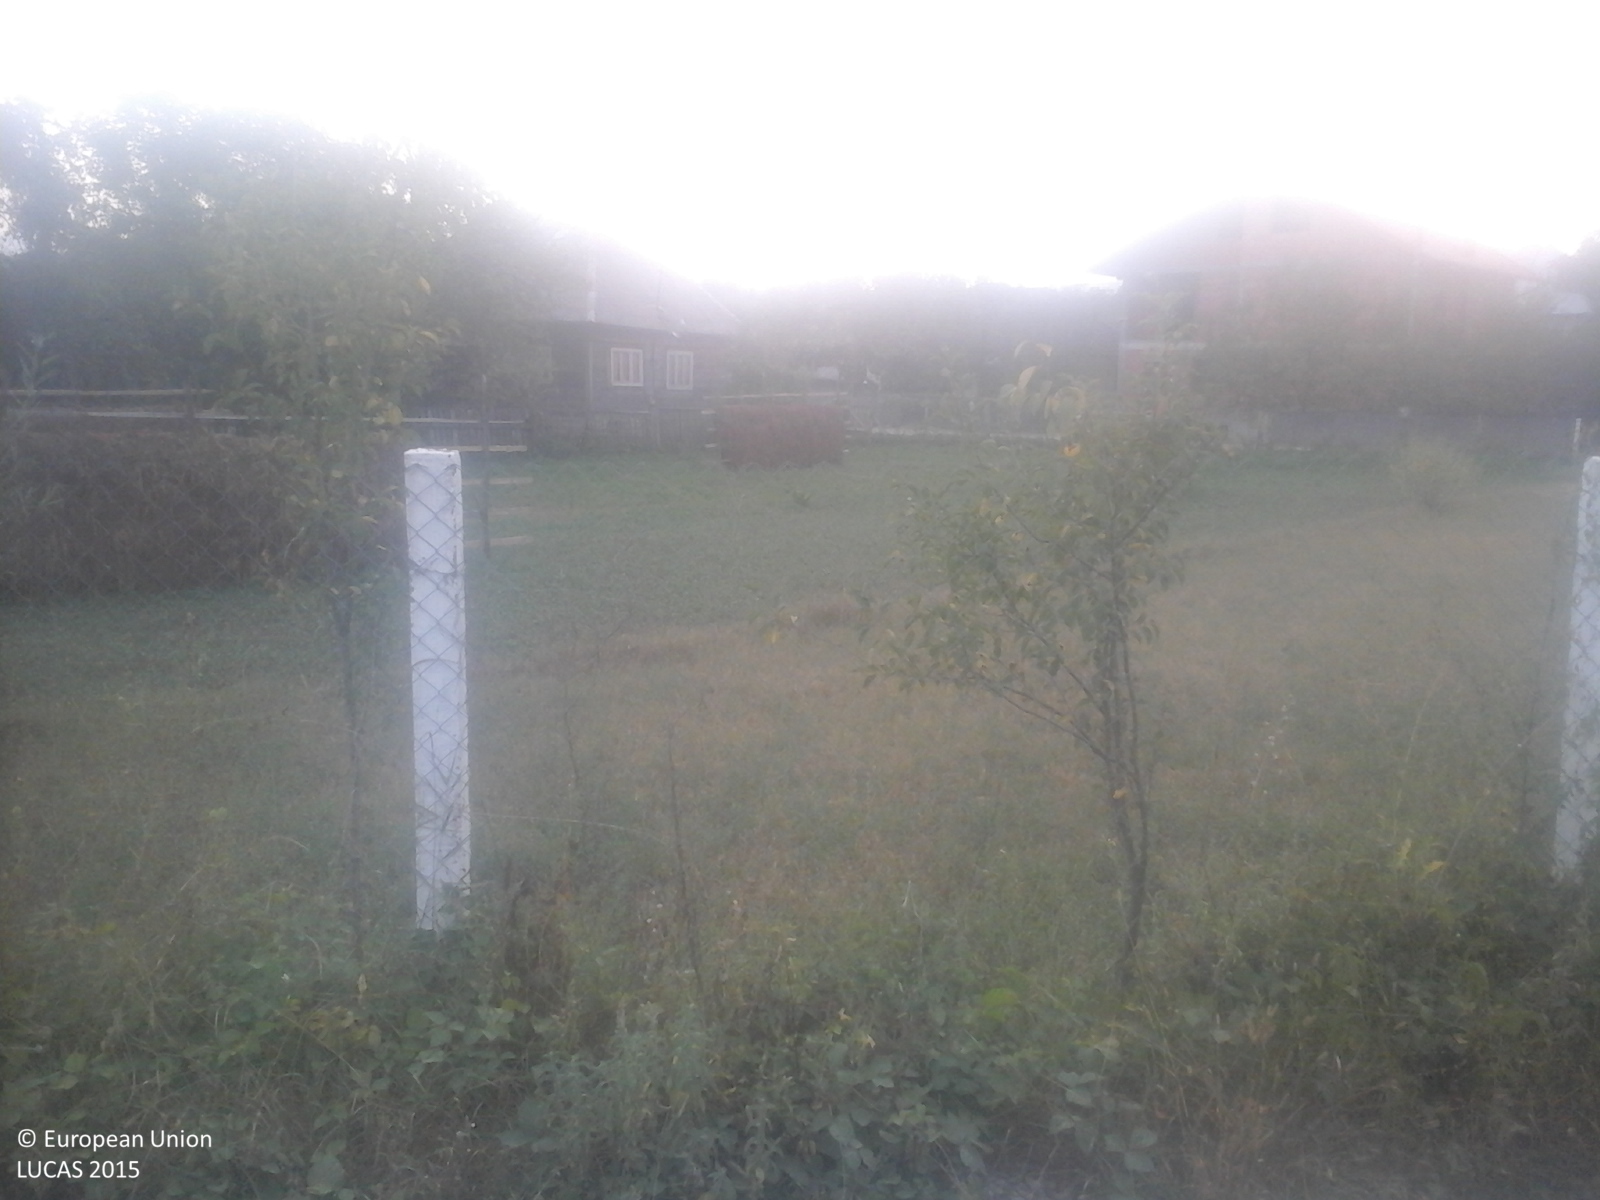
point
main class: Cropland
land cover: Lucerne
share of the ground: > 75 %
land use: Agriculture (excluding fallow land and kitchen gardens)
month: September
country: RO
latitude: 47.6934
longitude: 24.2530
